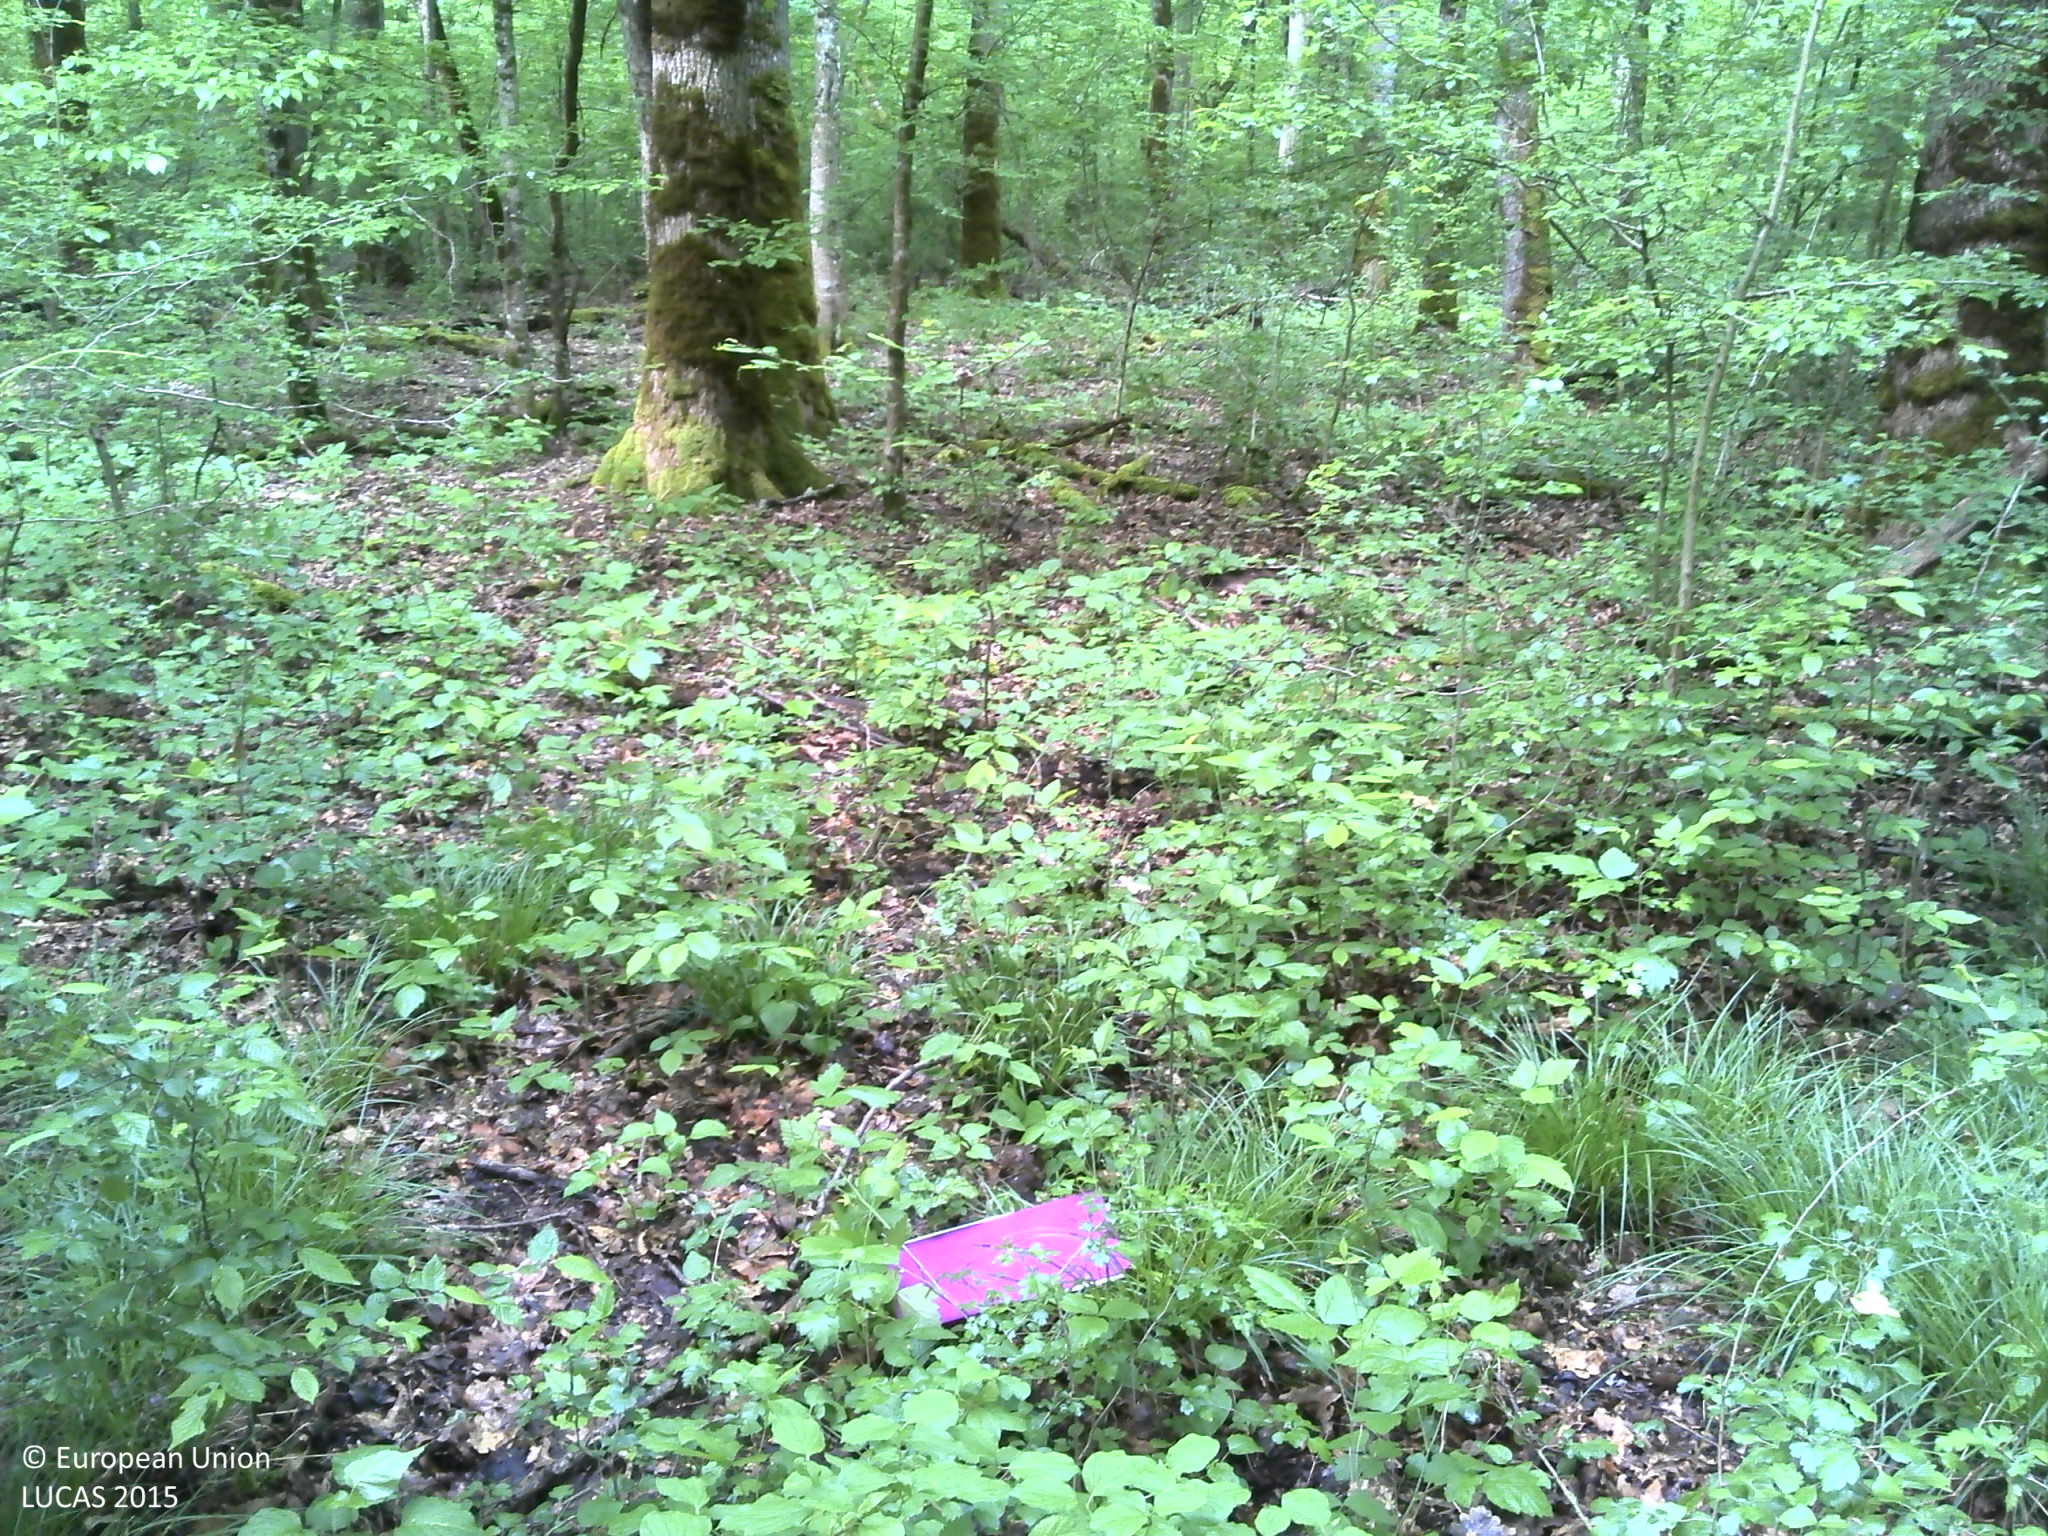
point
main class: Woodland
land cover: Broadleaved woodland
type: mesophytic deciduous forest
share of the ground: > 75 %
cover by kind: broadleaved forest trees 100 %
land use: Forestry
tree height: > 5 m
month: May
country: HR
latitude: 45.0347
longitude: 18.9304
